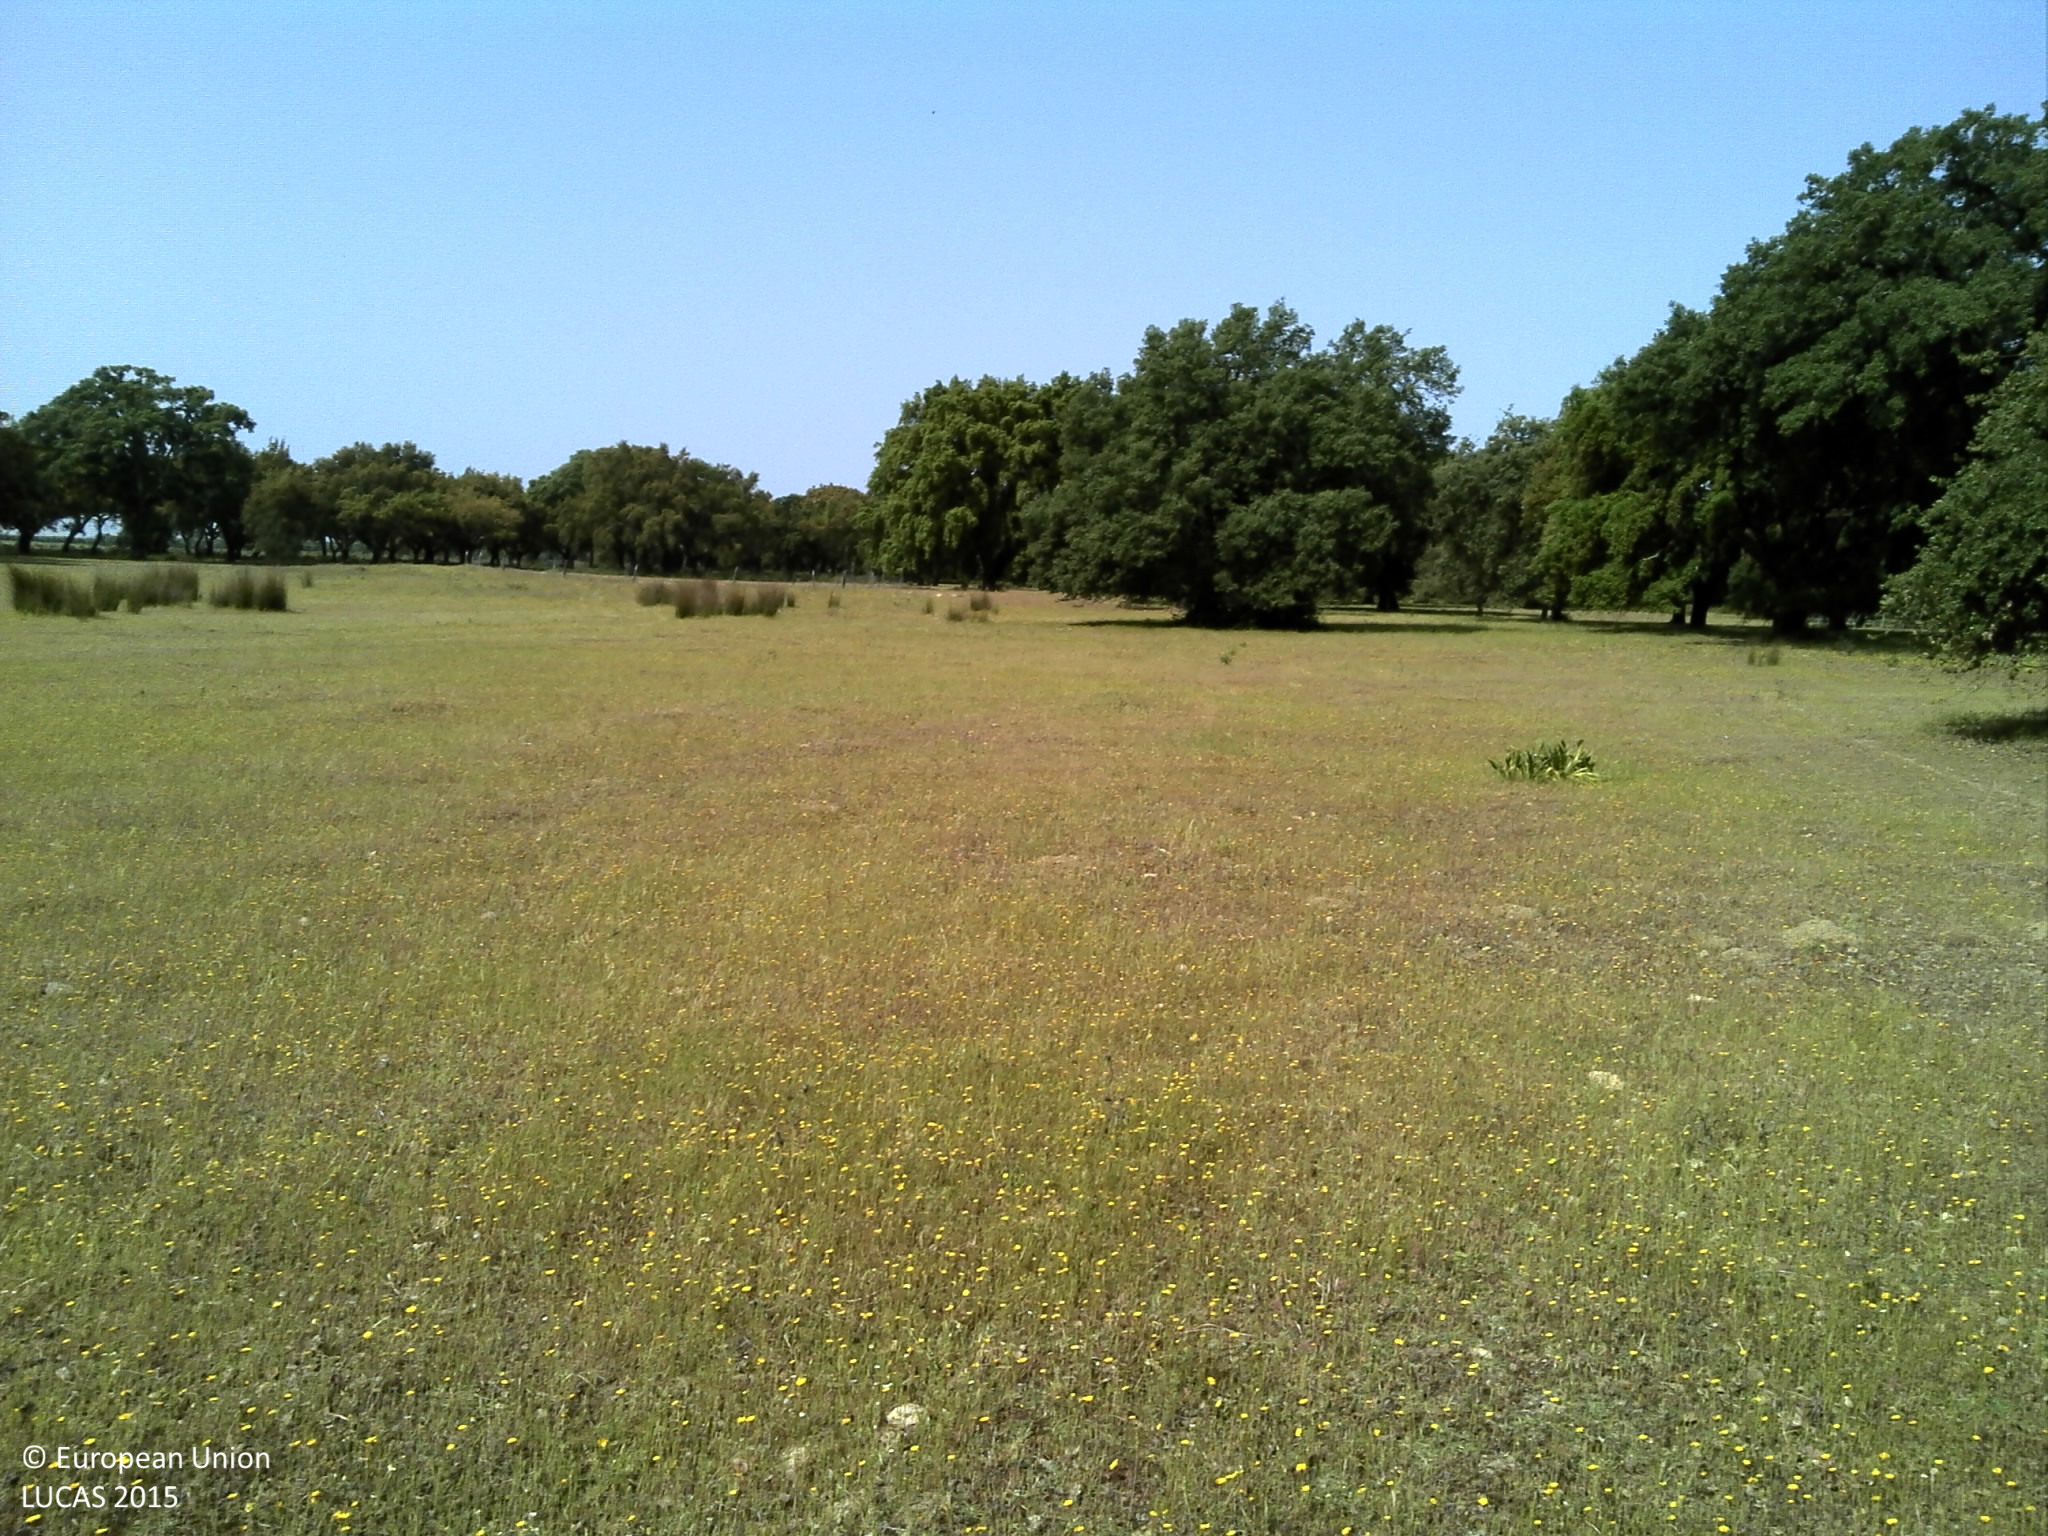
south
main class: Woodland
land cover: Broadleaved woodland
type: broadleaved evergreen forest
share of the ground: 10 - 25 %
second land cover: Grassland without tree/shrub cover
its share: 10 - 25 %
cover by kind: unconsolidated bare surface 65 %, herbaceous plants 25 %, broadleaved forest trees 10 %
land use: Forestry
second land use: Agriculture (excluding fallow land and kitchen gardens)
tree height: > 5 m
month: May
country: PT
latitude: 38.9700
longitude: -7.8311
